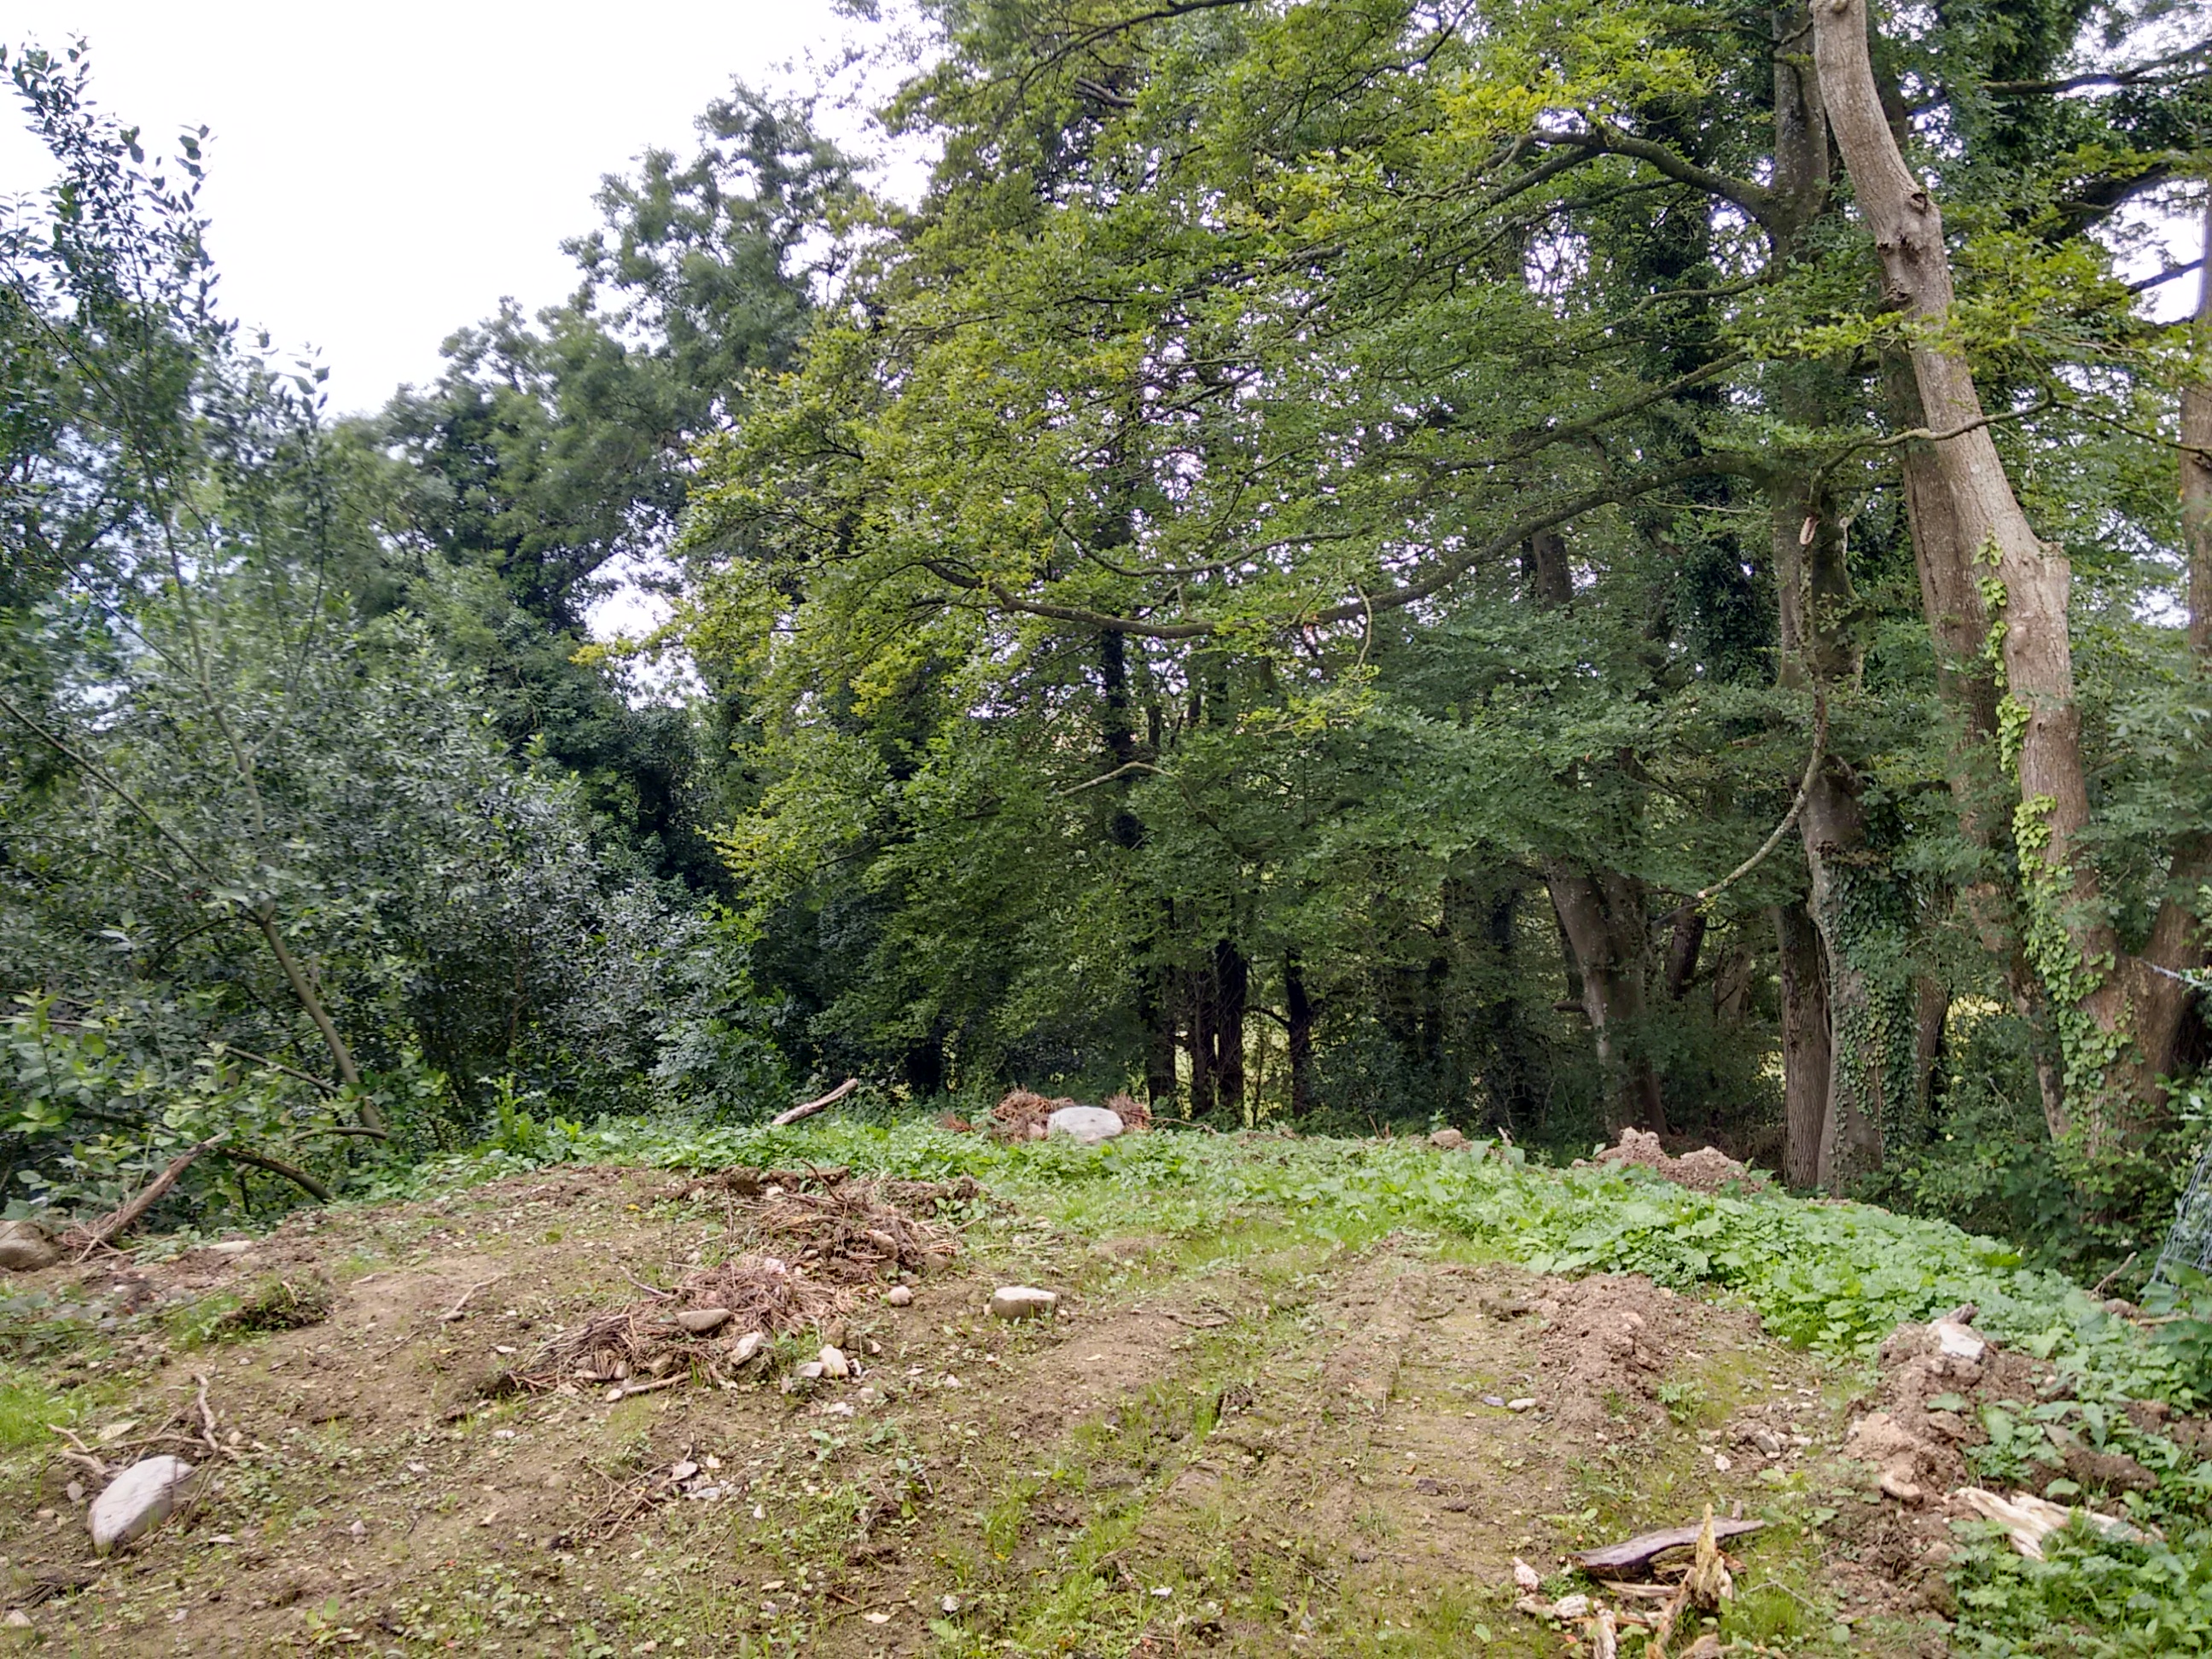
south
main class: Grassland
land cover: Grassland without tree/shrub cover
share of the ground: > 75 %
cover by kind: herbaceous plants 100 %
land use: Agriculture (excluding fallow land and kitchen gardens)
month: August
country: GB
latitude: 54.5982
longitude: -6.8675
